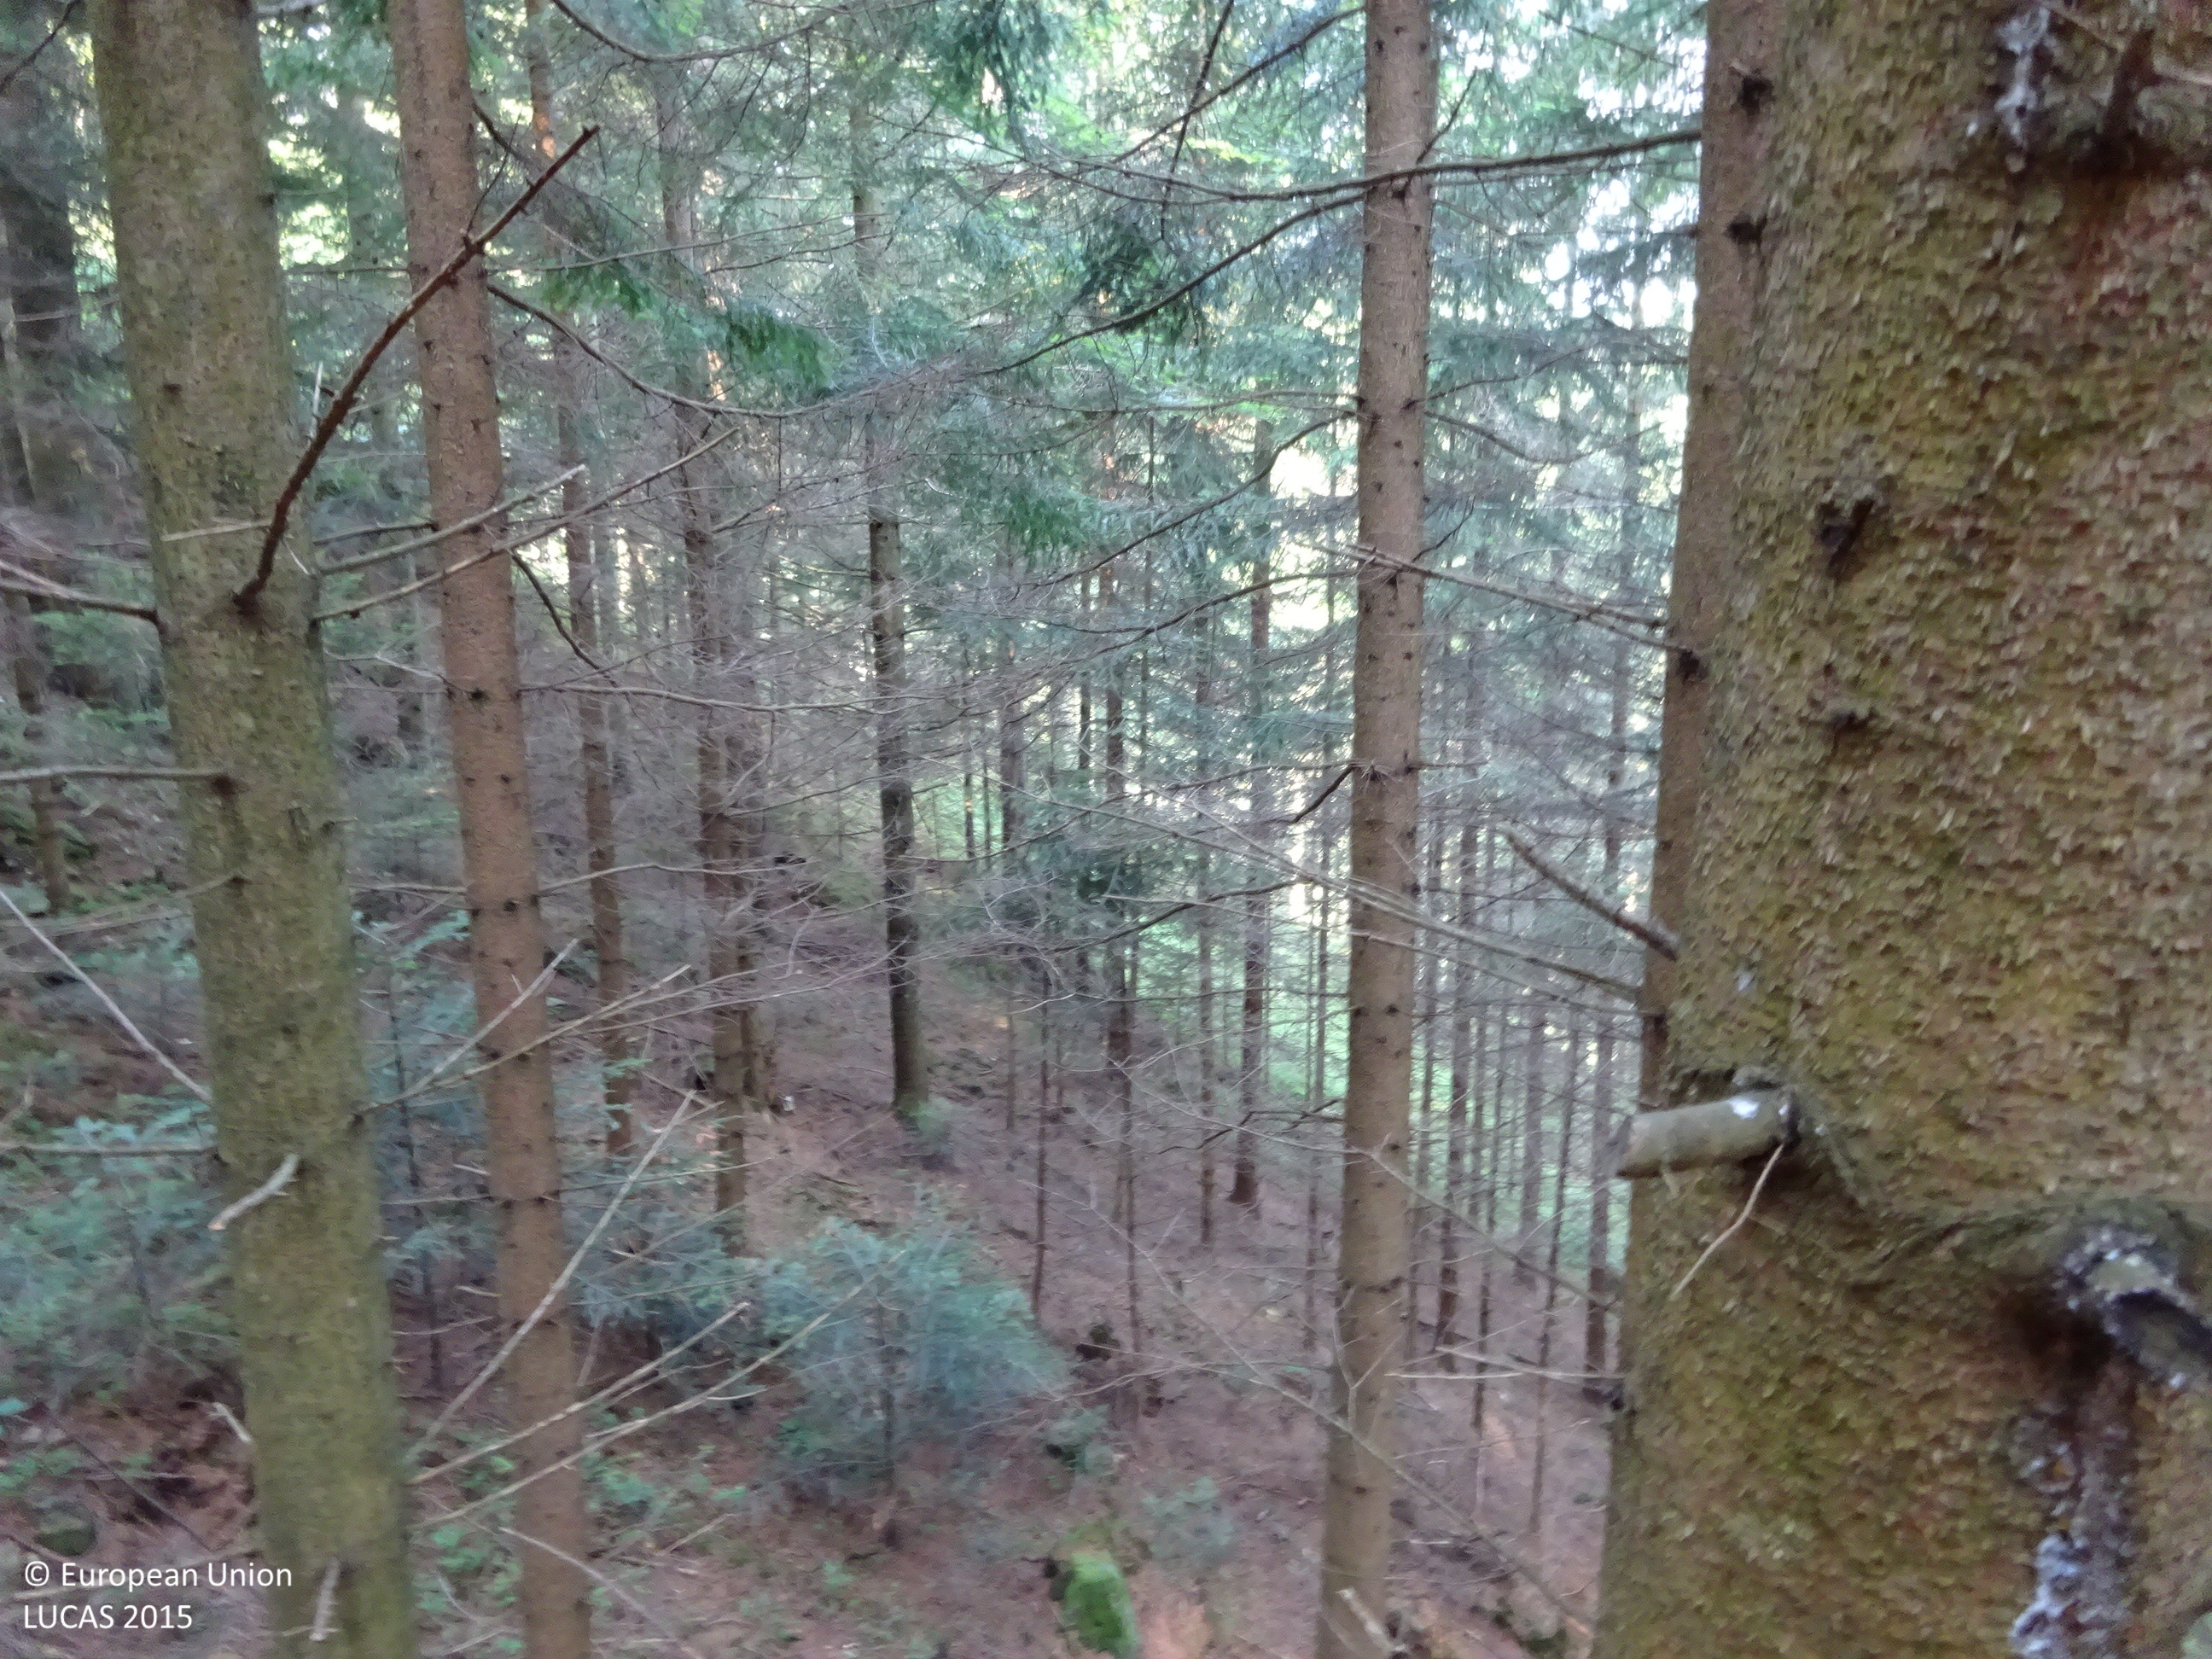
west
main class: Woodland
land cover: Spruce dominated coniferous woodland
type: alpine coniferous forest
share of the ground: > 75 %
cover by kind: coniferous forest trees 95 %, unconsolidated bare surface 5 %
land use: Forestry
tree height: > 5 m
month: August
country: AT
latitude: 47.3899
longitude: 15.7109
